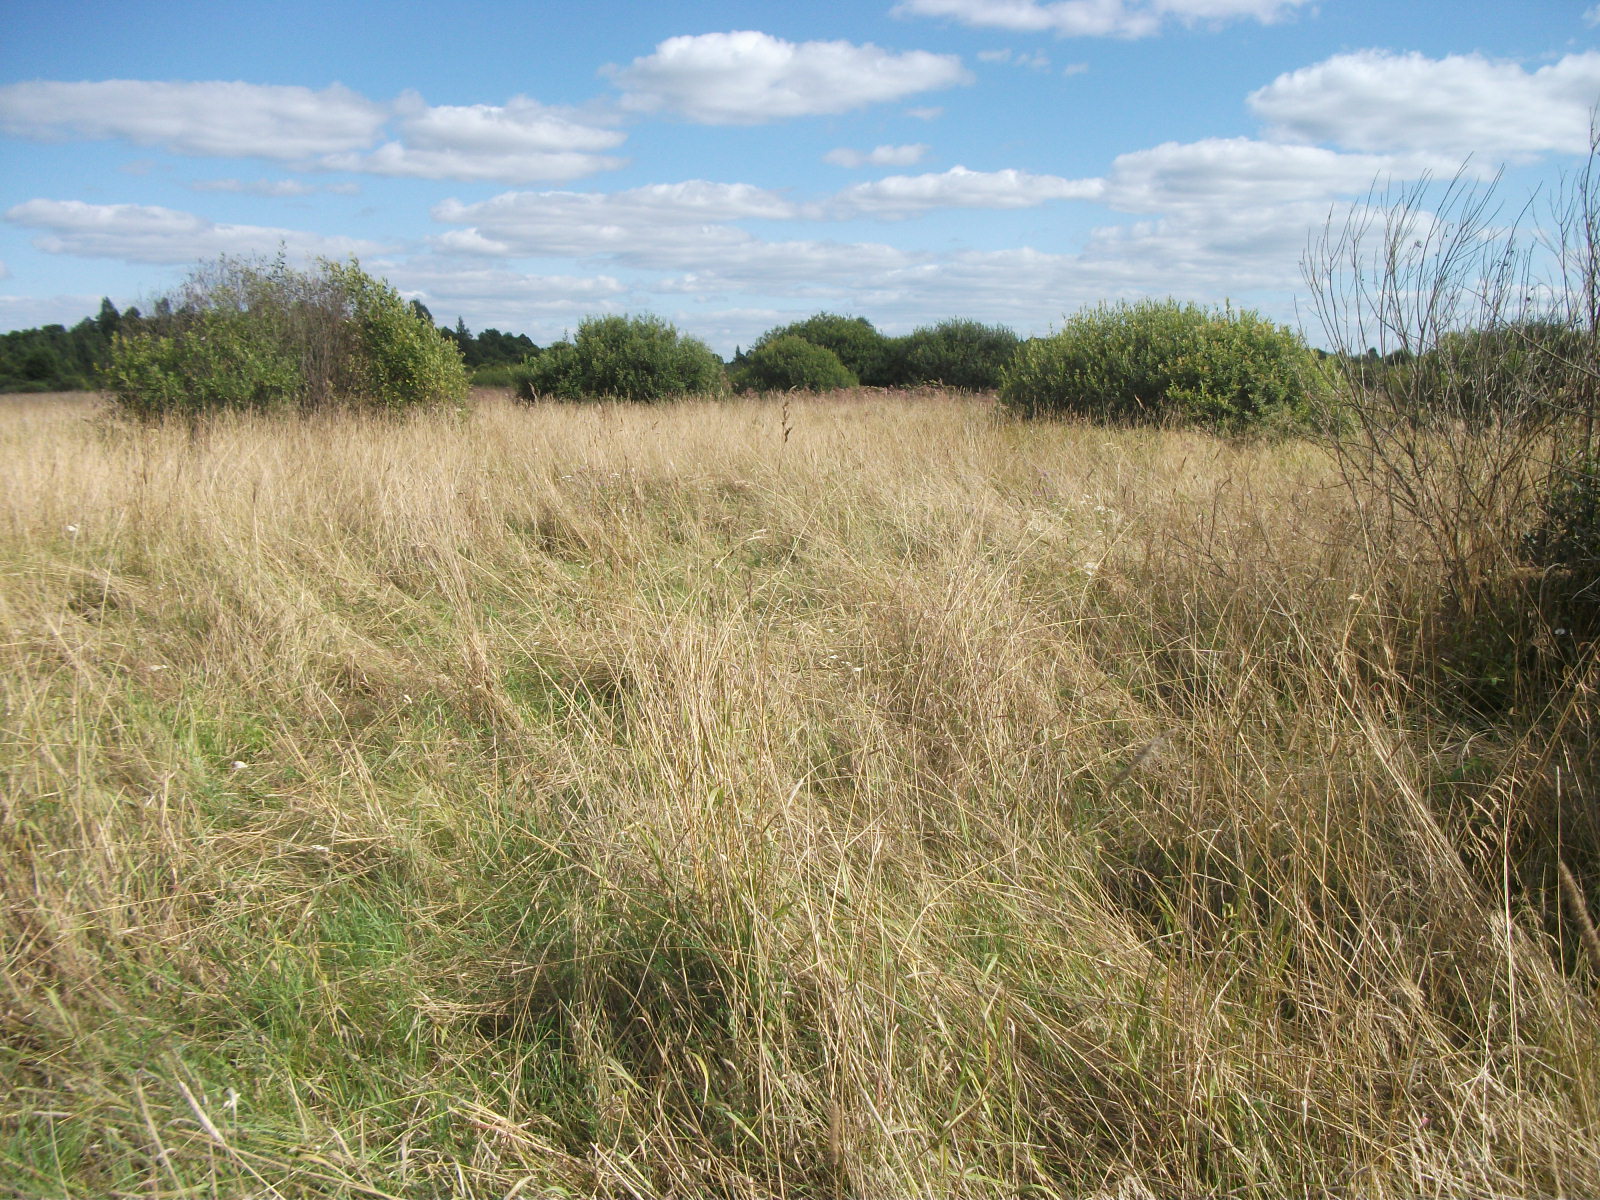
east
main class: Grassland
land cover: Grassland with sparse tree/shrub cover
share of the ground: > 75 %
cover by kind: herbaceous plants 85 %, shrubs 10 %, broadleaved forest trees 5 %
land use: Abandoned areas
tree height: < 5 m
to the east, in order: Grassland with sparse tree/shrub cover; Grassland without tree/shrub cover
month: August
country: LV
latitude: 56.4095
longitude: 26.4007
